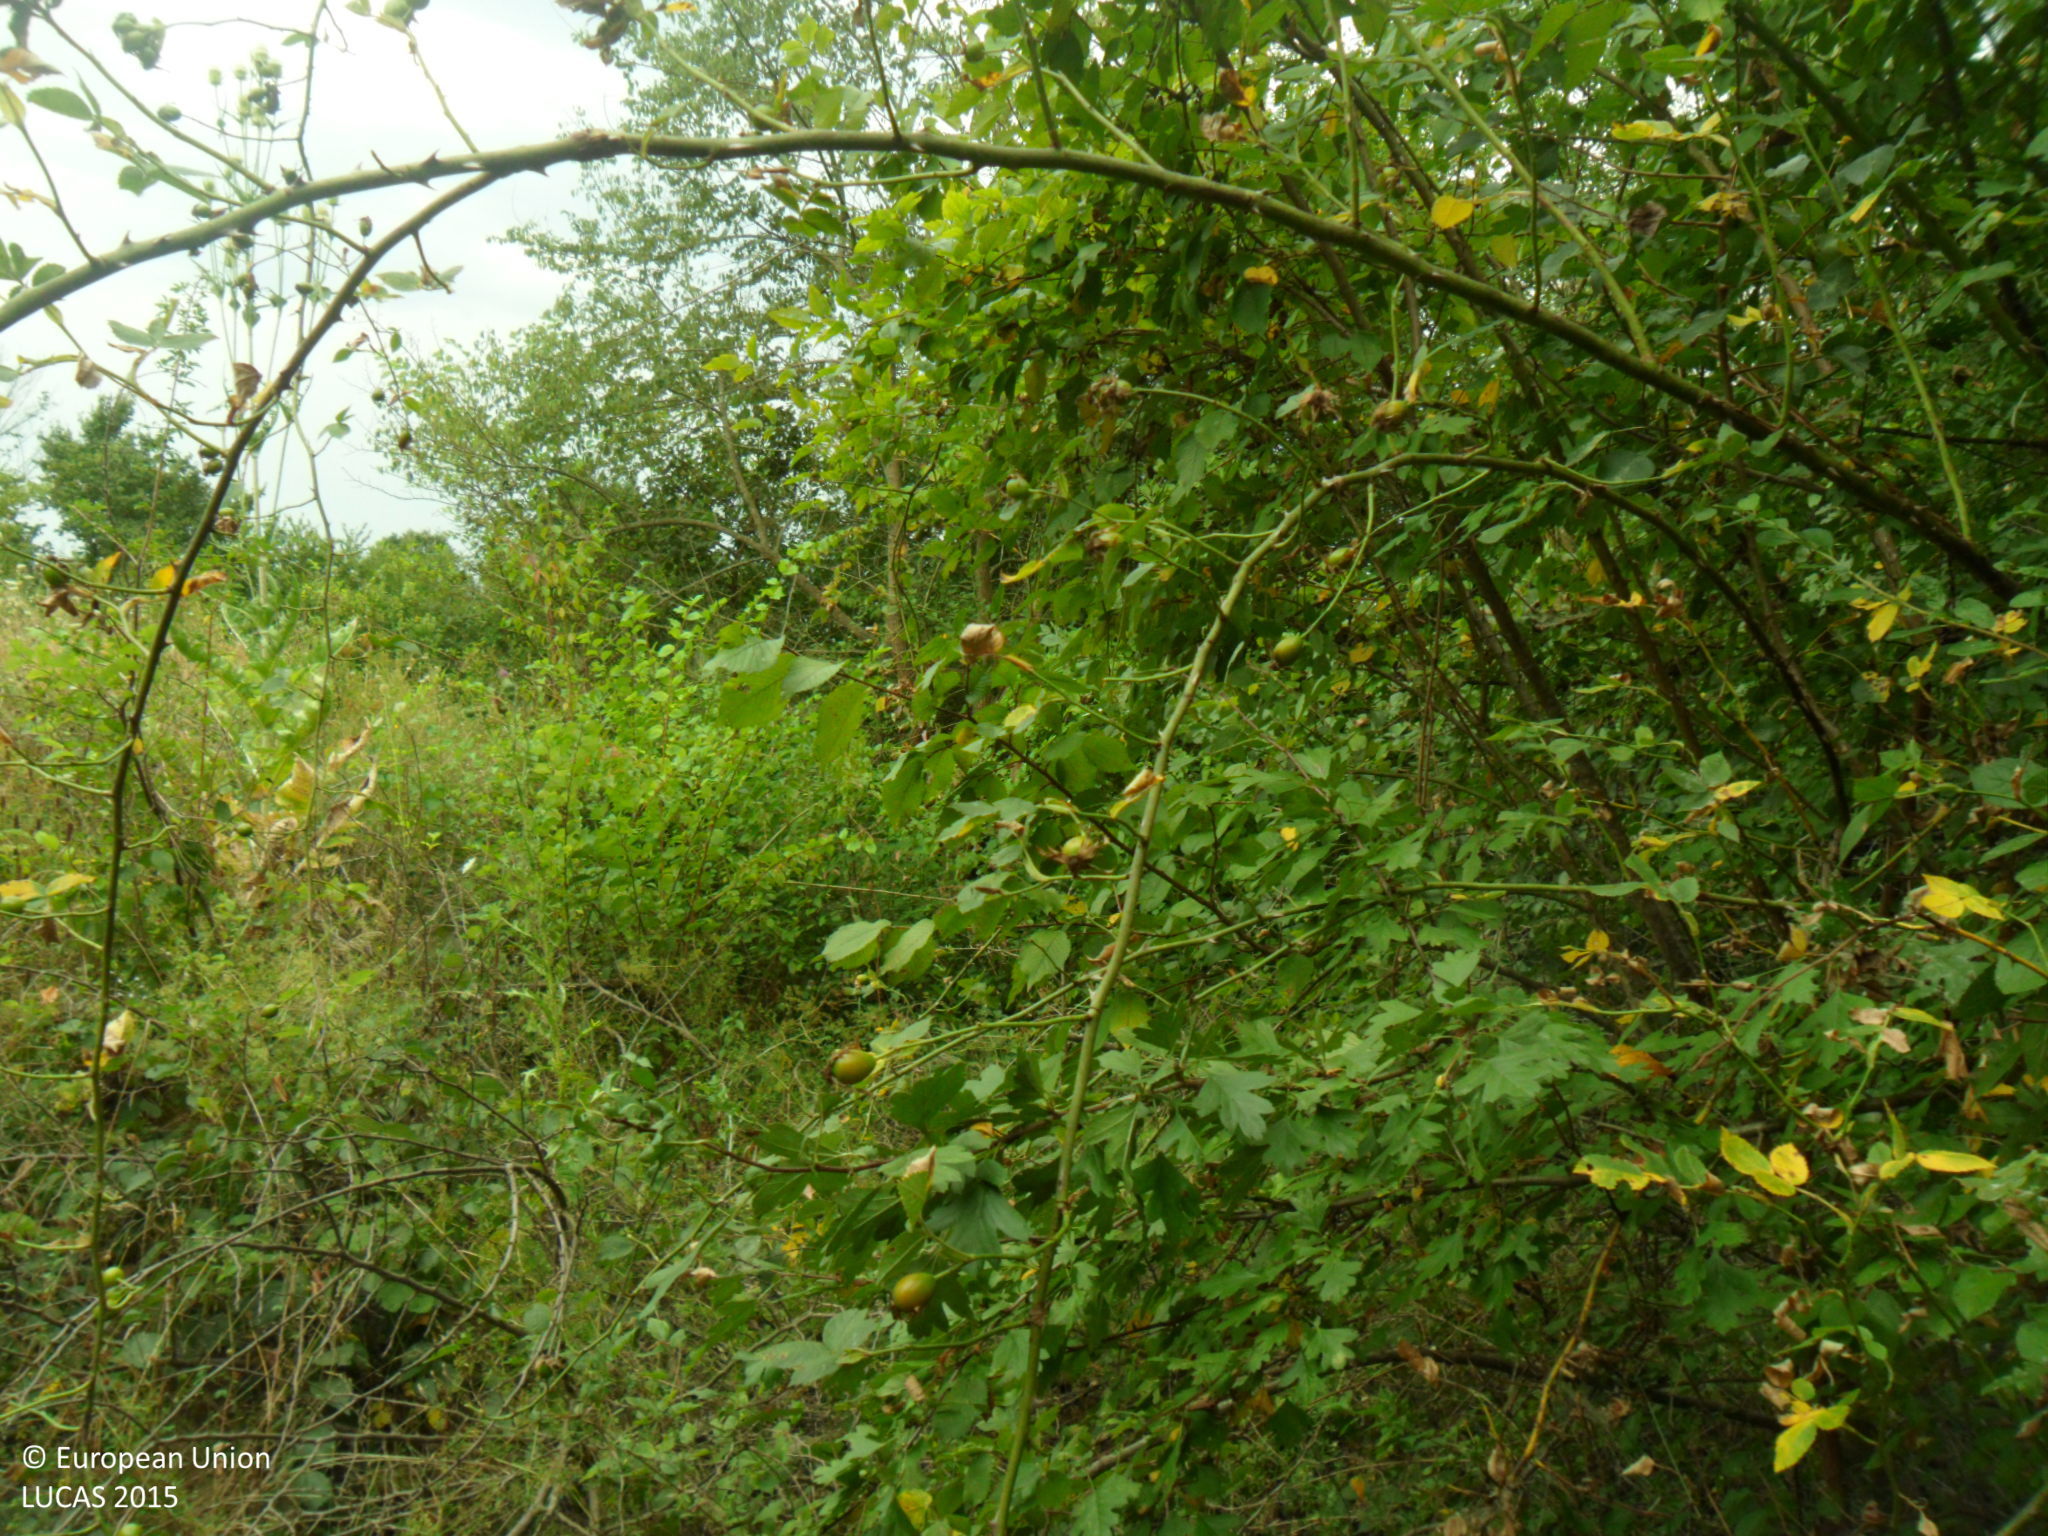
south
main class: Shrubland
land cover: Shrubland with sparse tree cover
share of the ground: > 75 %
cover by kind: shrubs 95 %, broadleaved forest trees 5 %
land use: Semi-natural and natural areas not in use
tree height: > 5 m
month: August
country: BG
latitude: 43.0563
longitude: 26.7167
